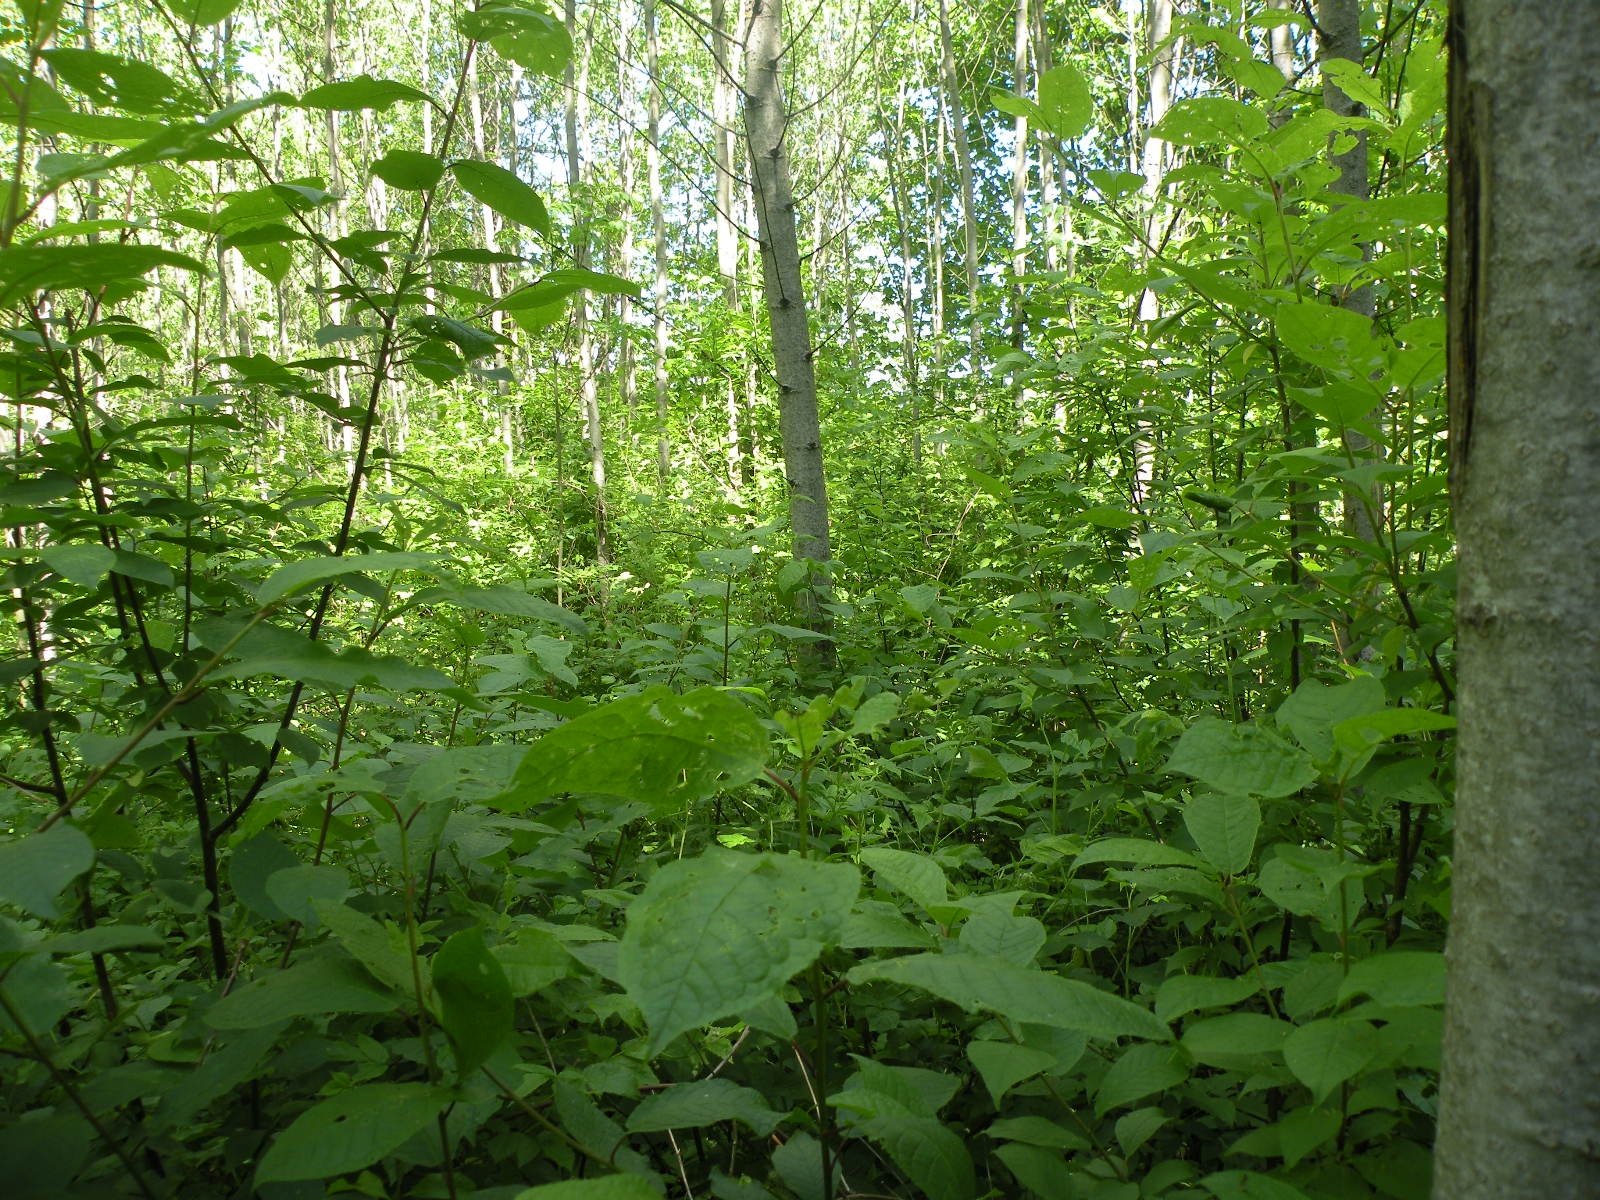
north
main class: Woodland
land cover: Broadleaved woodland
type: non-riverine alder, birch or aspen forest
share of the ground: > 75 %
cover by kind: broadleaved forest trees 85 %, herbaceous plants 10 %, shrubs 5 %
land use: Forestry
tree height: > 5 m
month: May
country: LV
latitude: 55.9950
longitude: 26.1899
